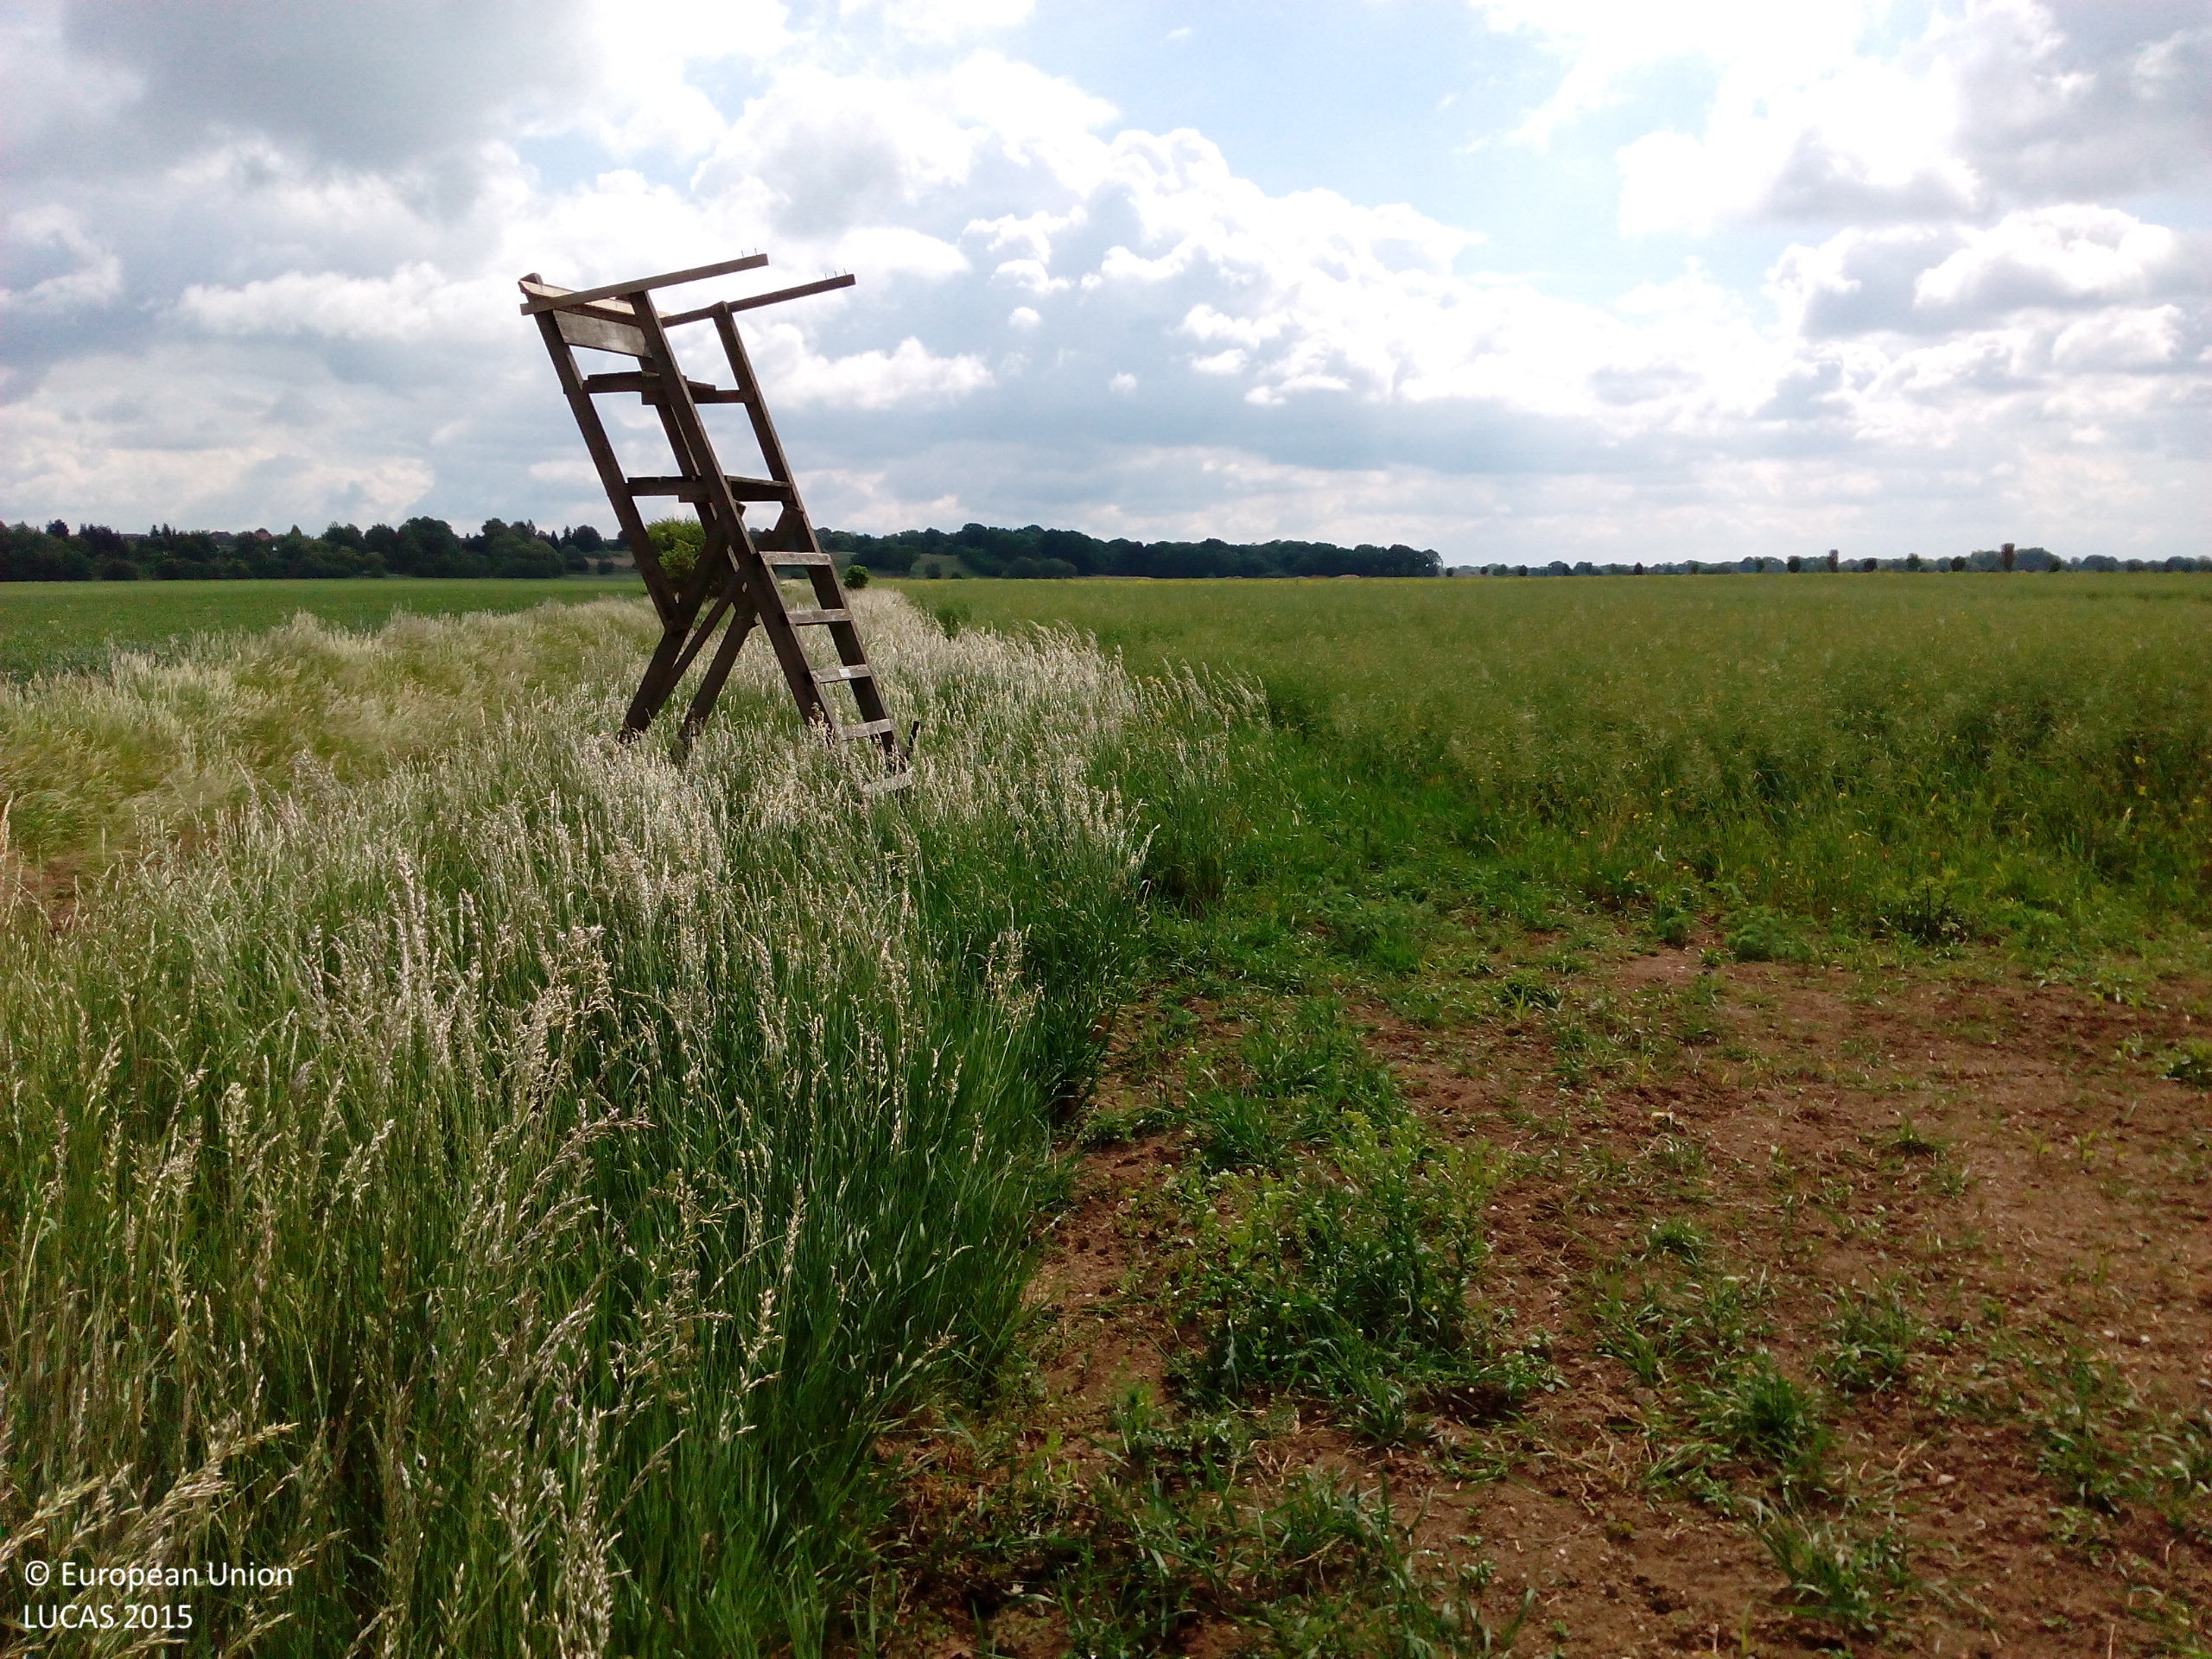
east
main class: Cropland
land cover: Common wheat
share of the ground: > 75 %
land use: Agriculture (excluding fallow land and kitchen gardens)
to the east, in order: Common wheat
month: May
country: DE
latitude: 51.6145
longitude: 12.4693
